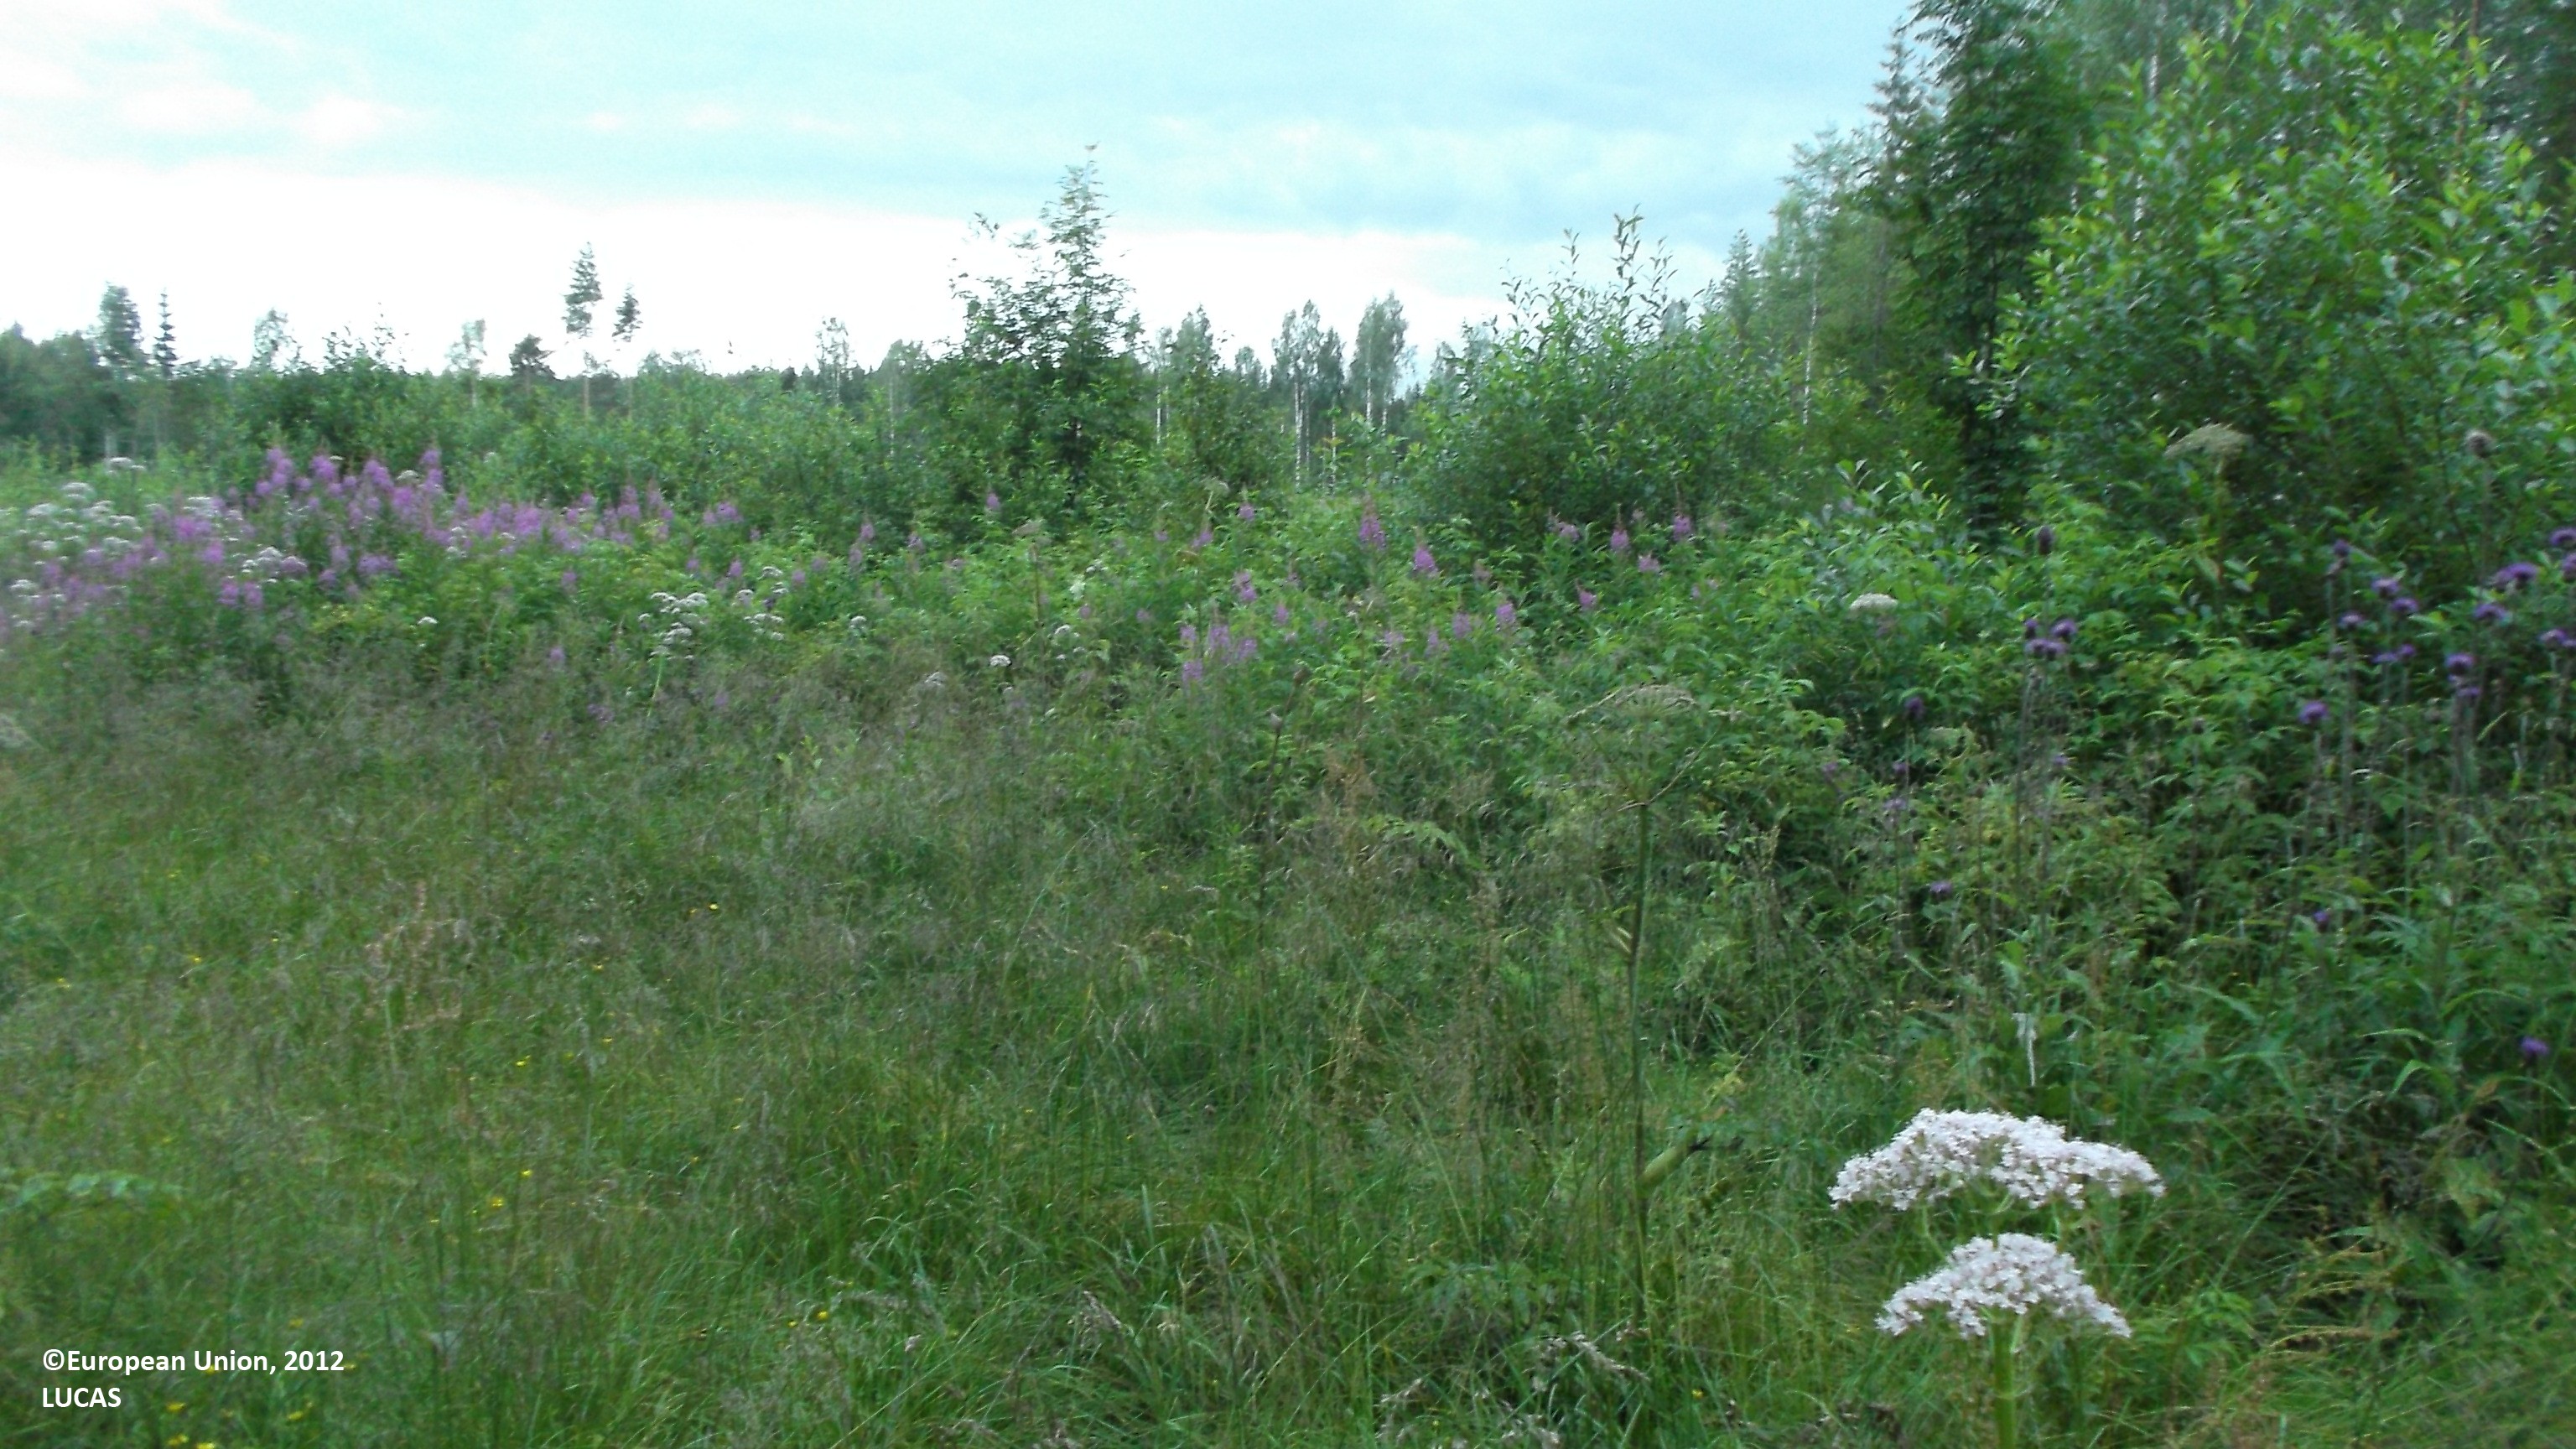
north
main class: Shrubland
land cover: Shrubland with sparse tree cover
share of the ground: > 75 %
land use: Forestry
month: July
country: FI
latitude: 63.6991
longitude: 23.3889
